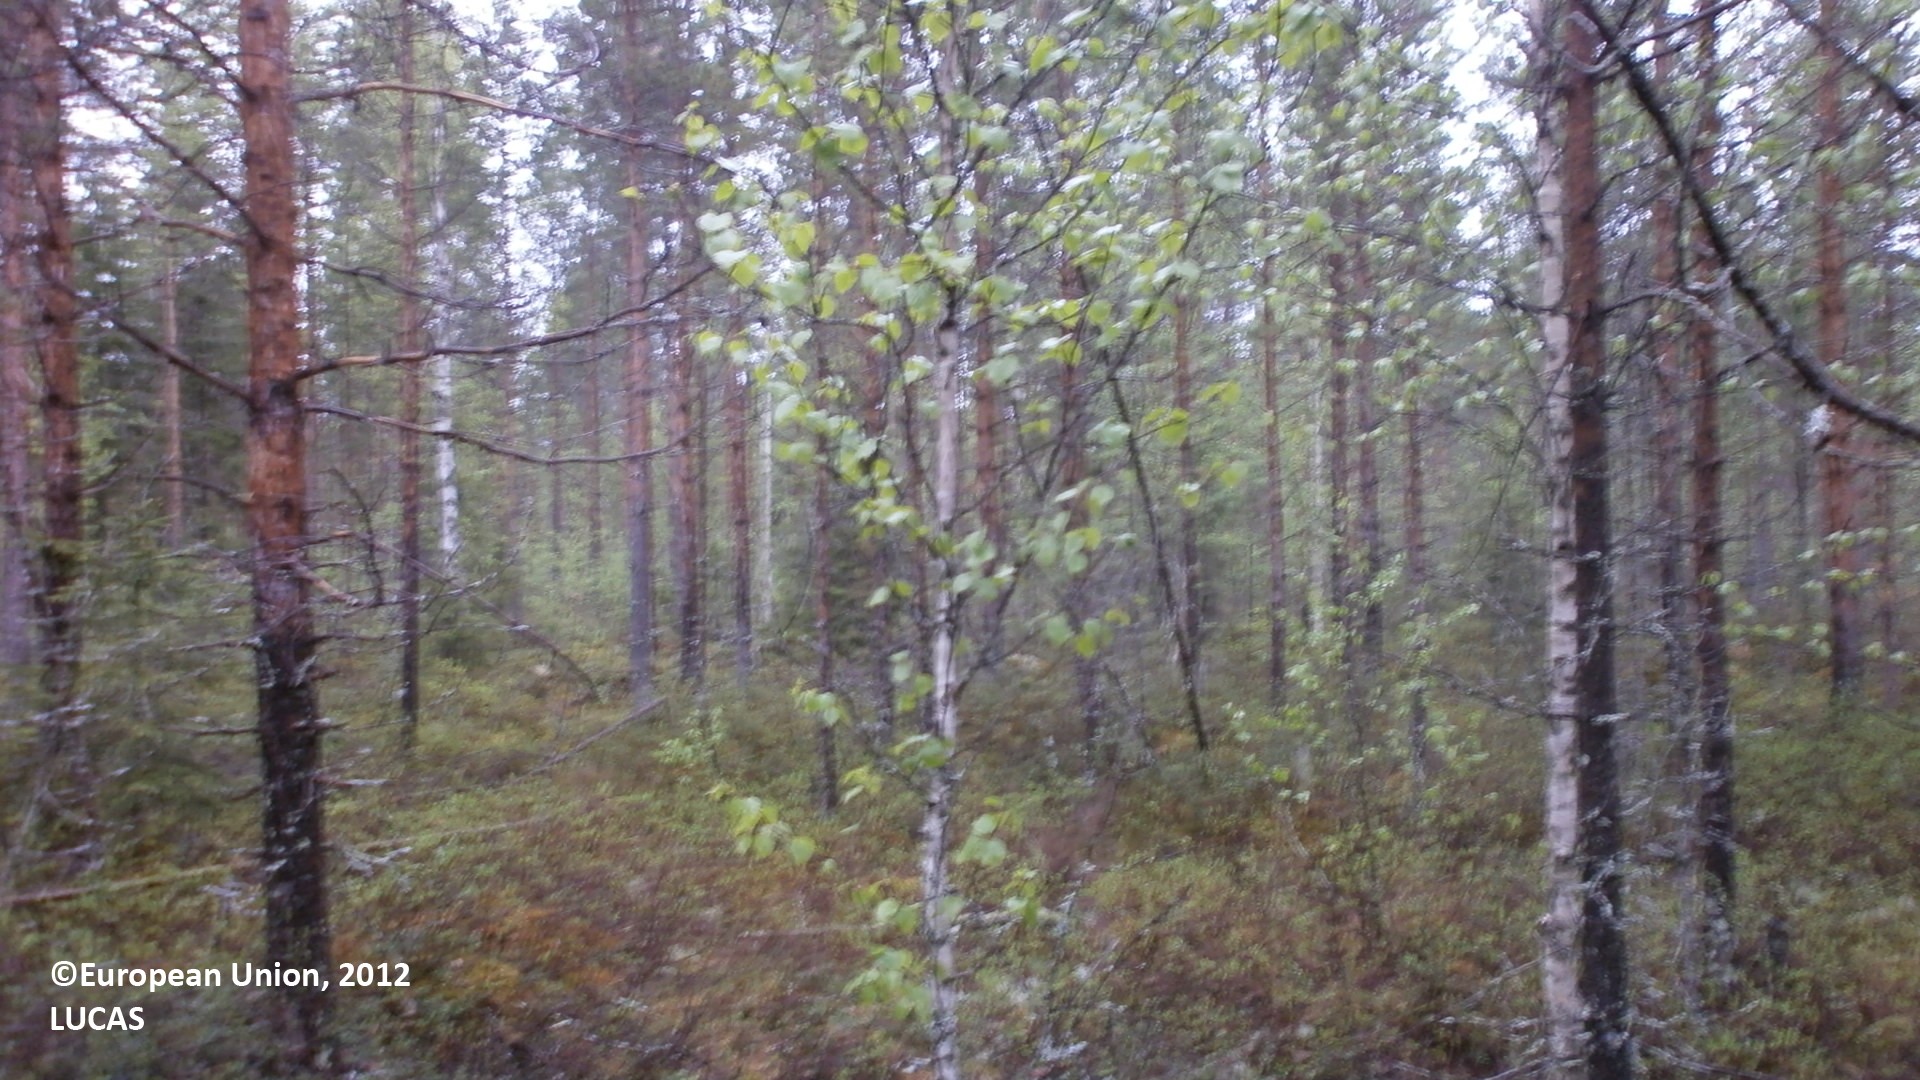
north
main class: Woodland
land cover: Pine dominated coniferous woodland
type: mire and swamp forests
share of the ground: 50 - 75 %
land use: Forestry
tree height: > 5 m
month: June
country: FI
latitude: 64.0877
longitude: 26.0863
